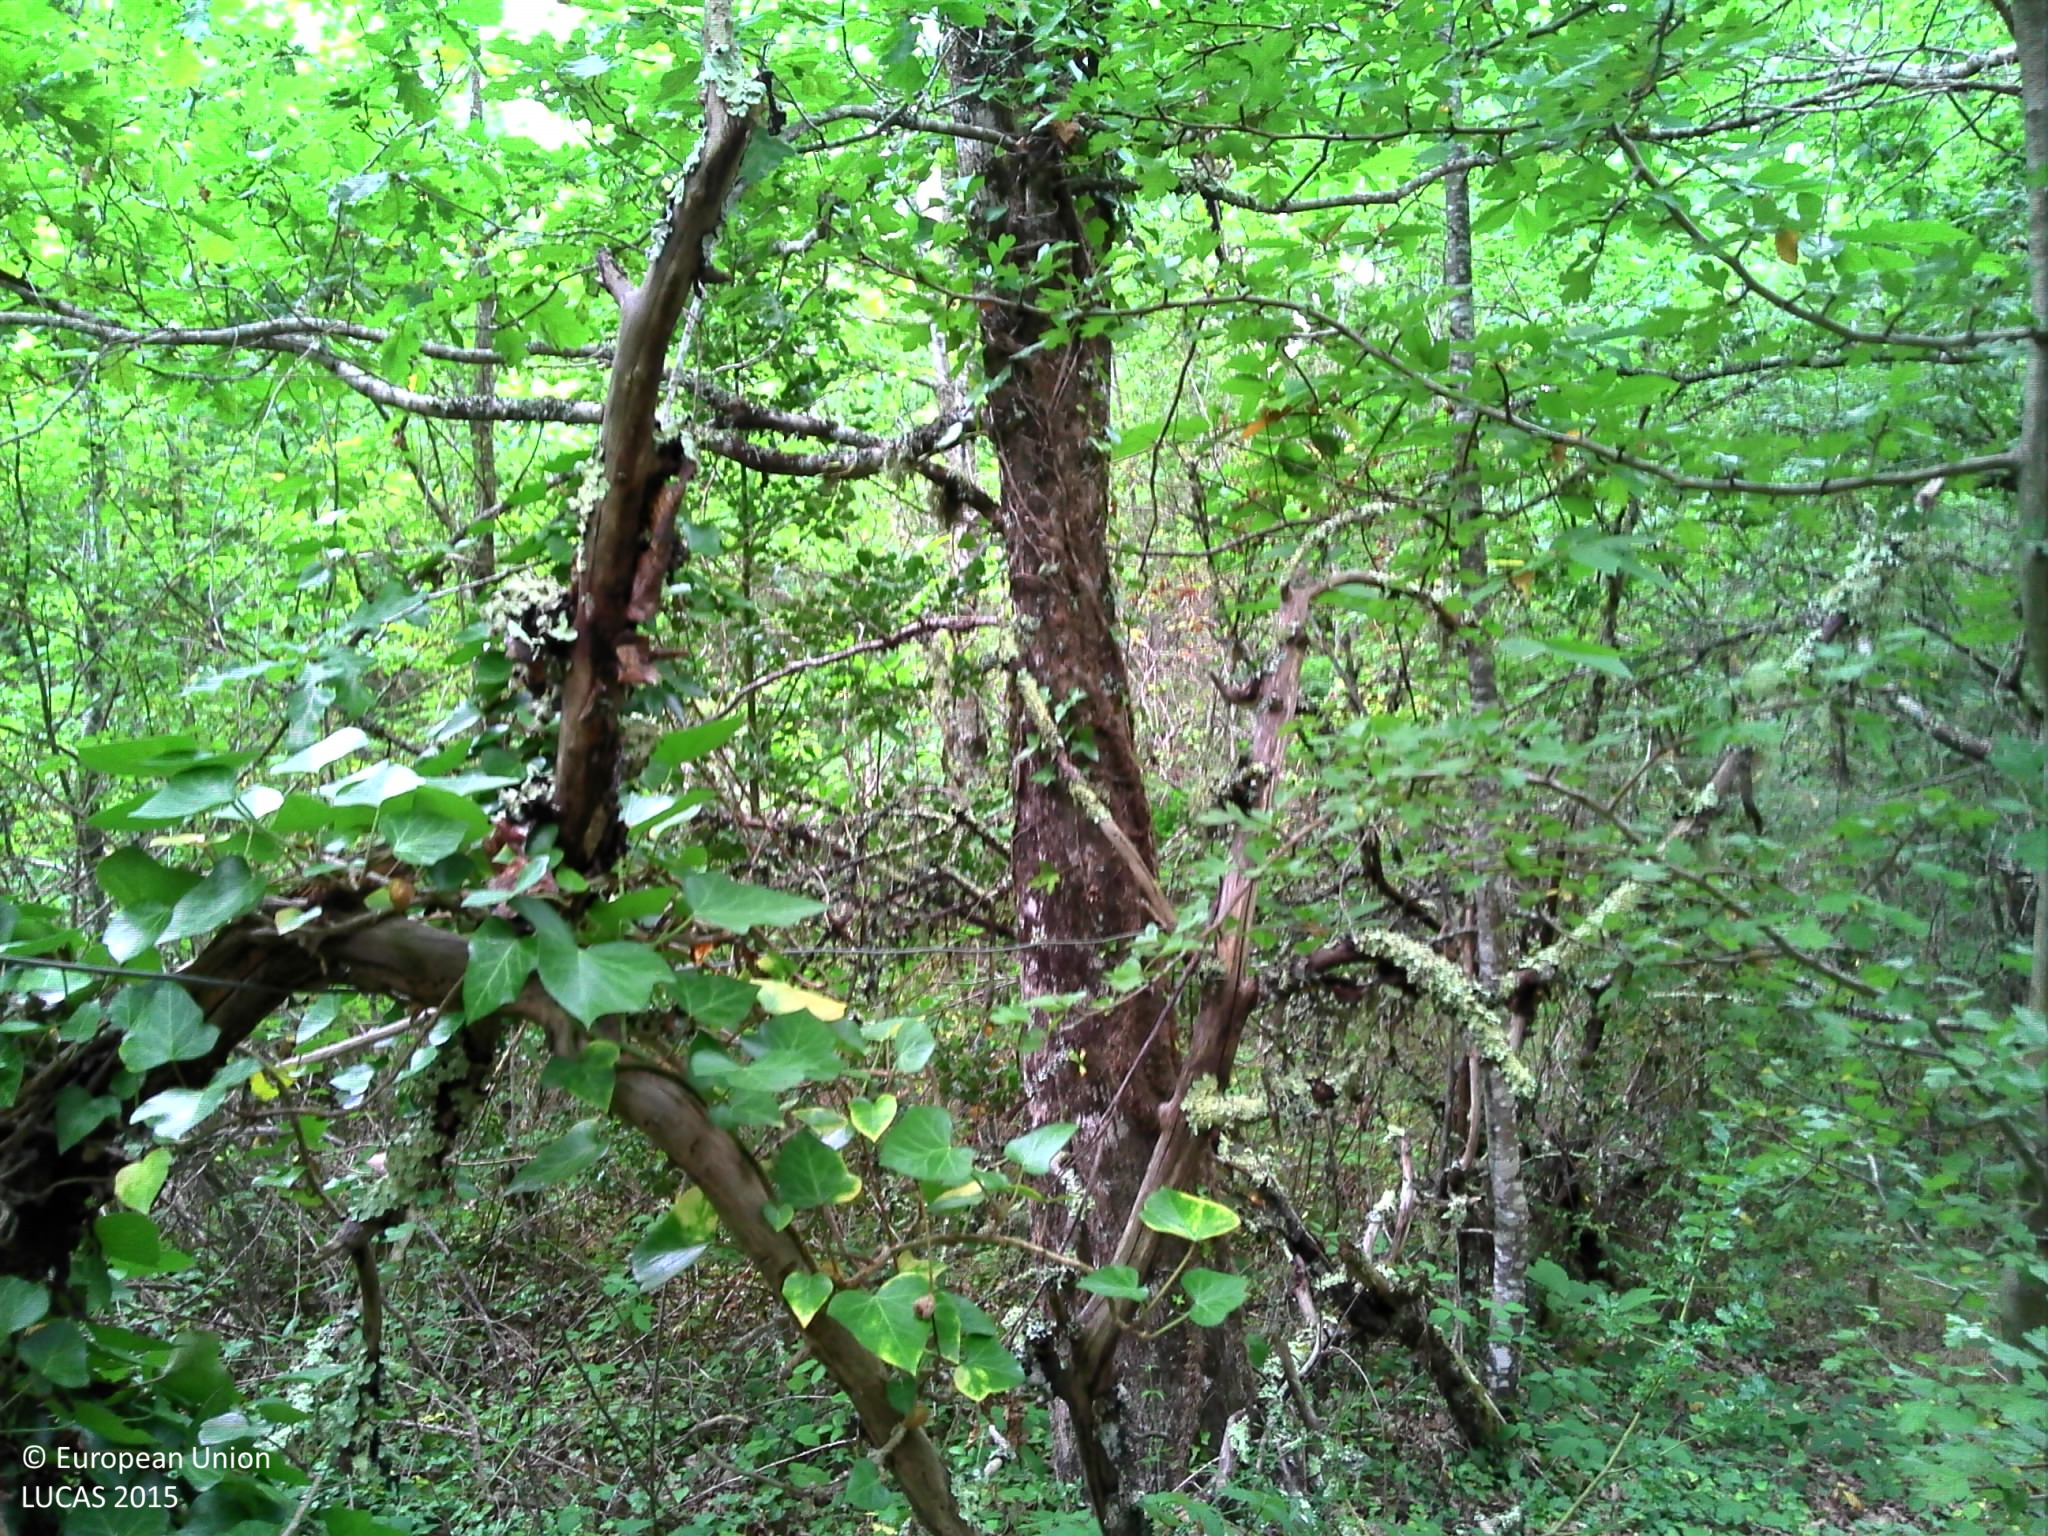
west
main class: Woodland
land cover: Broadleaved woodland
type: acidophilous oak and oak-birch forest
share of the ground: > 75 %
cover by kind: broadleaved forest trees 75 %, herbaceous plants 15 %, lichens and mosses 5 %, unconsolidated bare surface 5 %
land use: Semi-natural and natural areas not in use
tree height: > 5 m
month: July
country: FR
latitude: 45.0665
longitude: 0.8088
